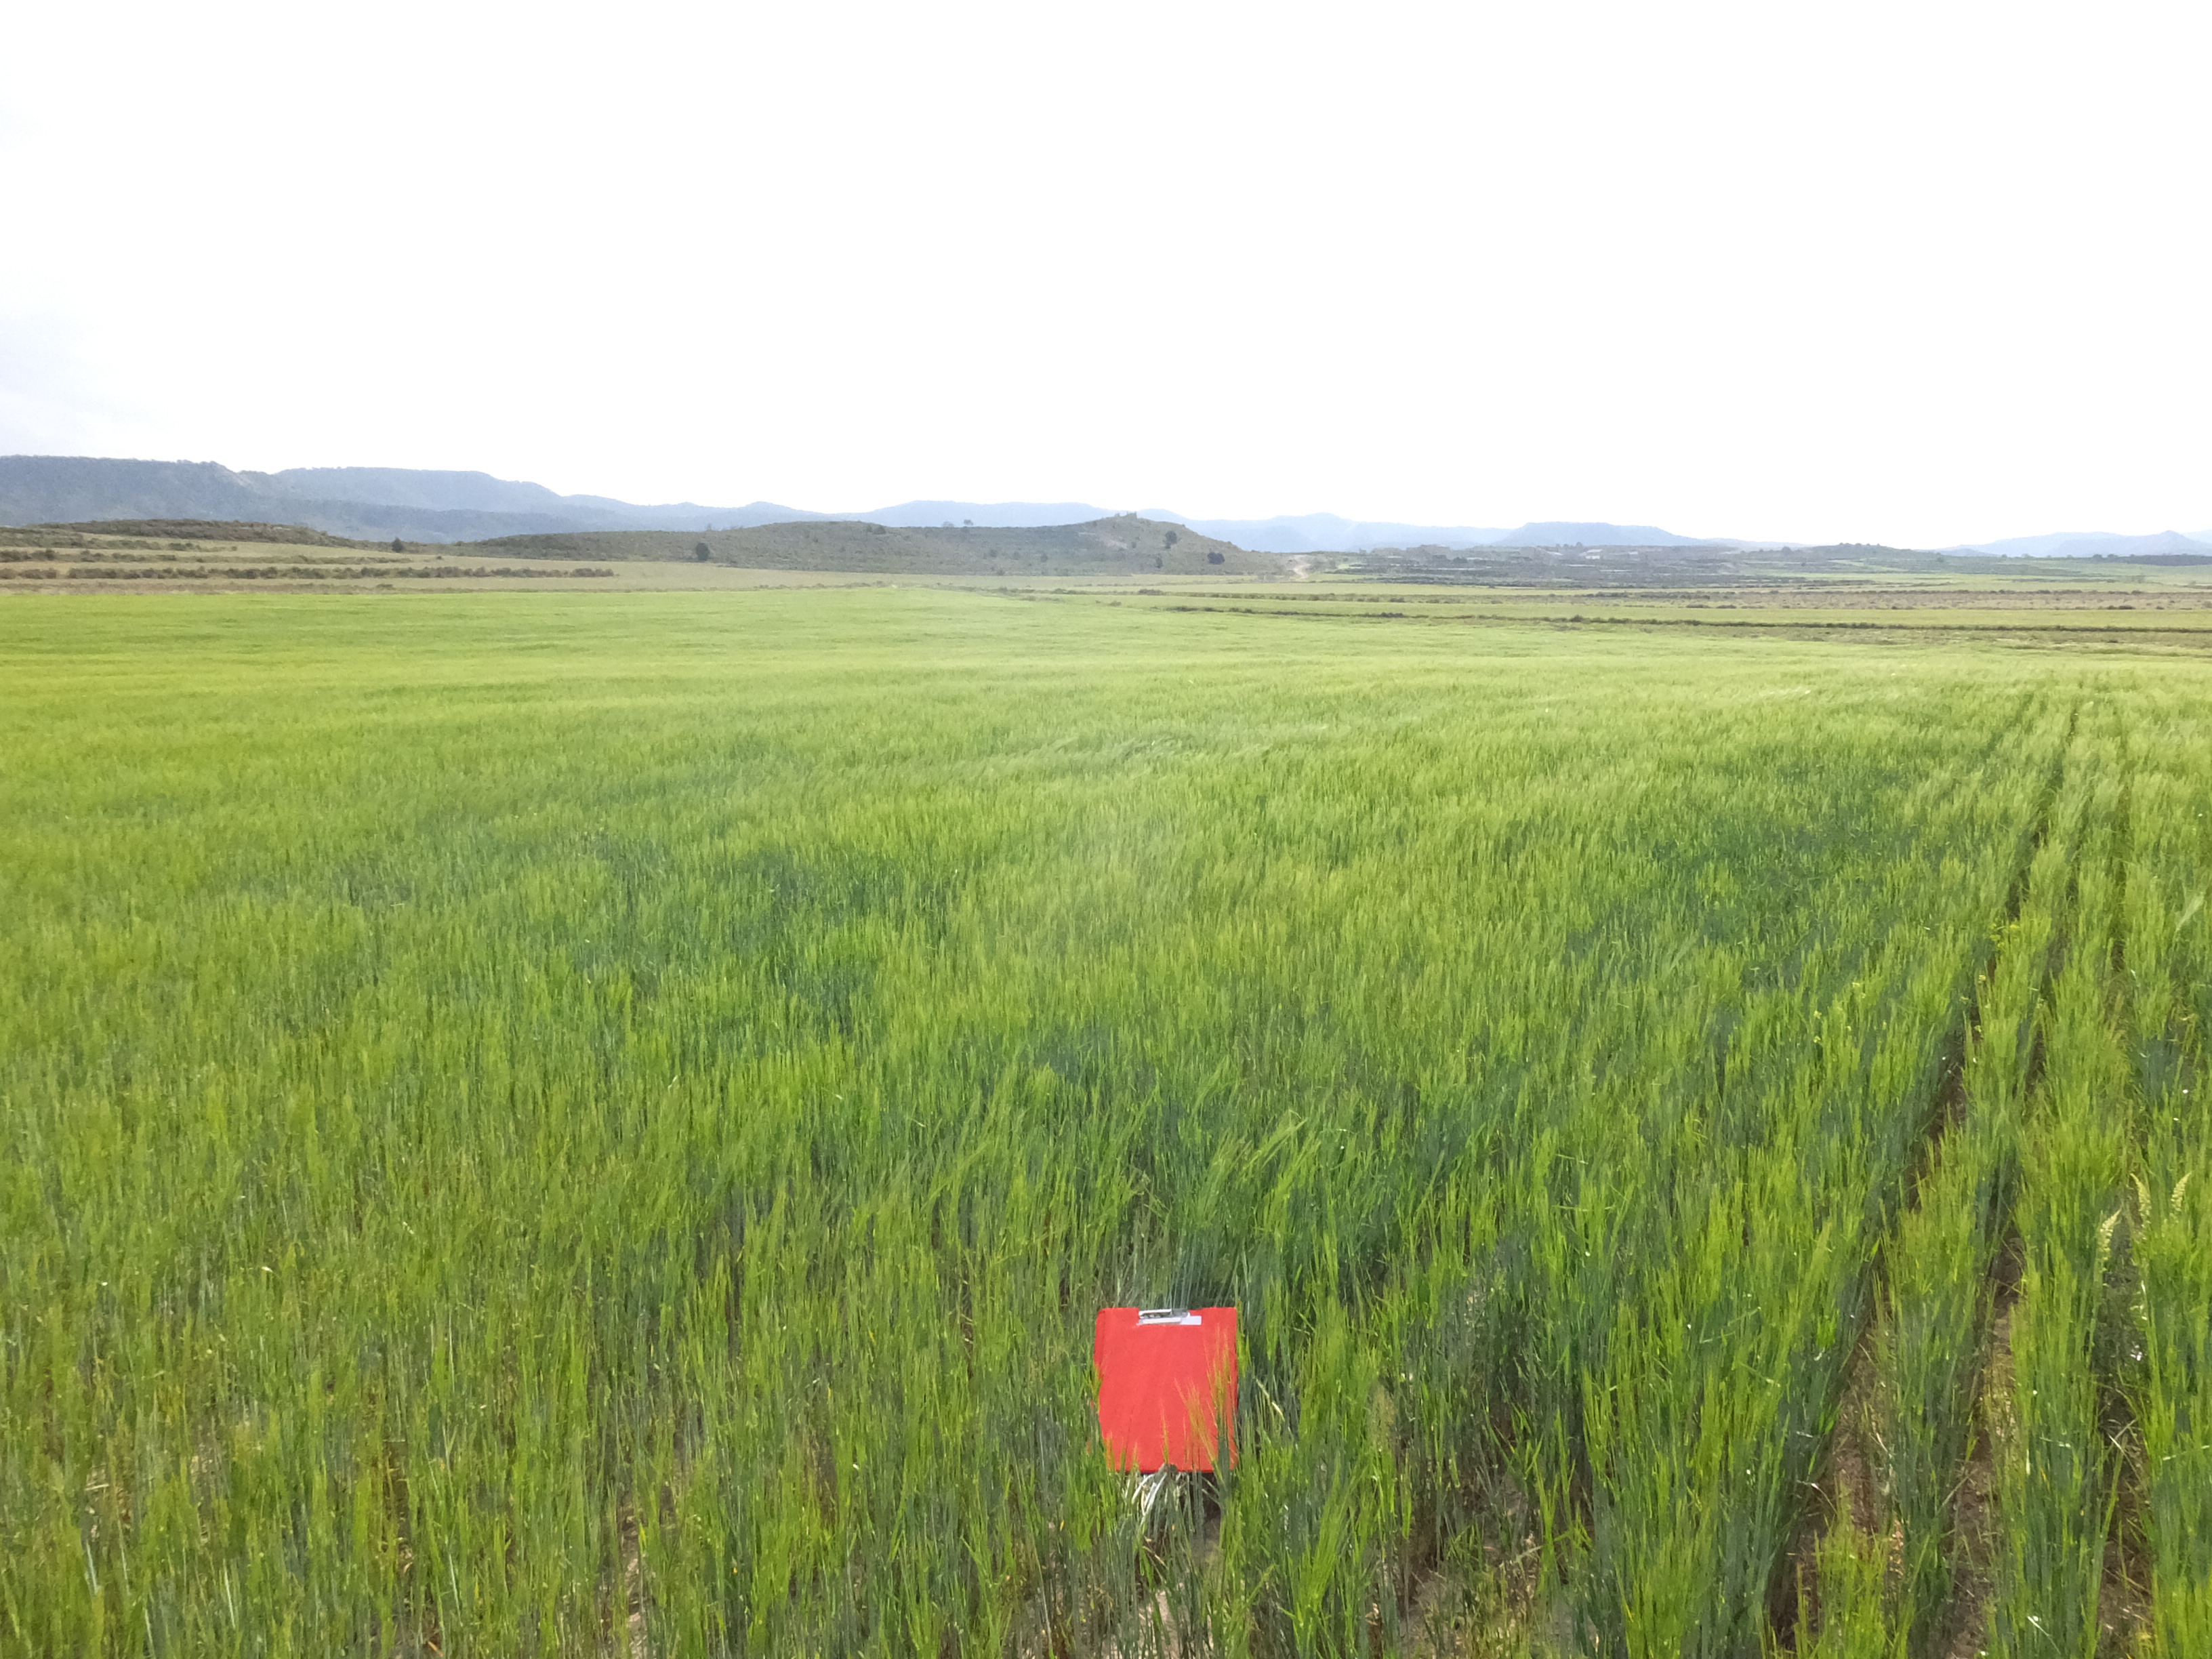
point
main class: Cropland
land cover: Barley
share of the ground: > 75 %
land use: Agriculture (excluding fallow land and kitchen gardens)
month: April
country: ES
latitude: 41.7227
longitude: -0.3444
